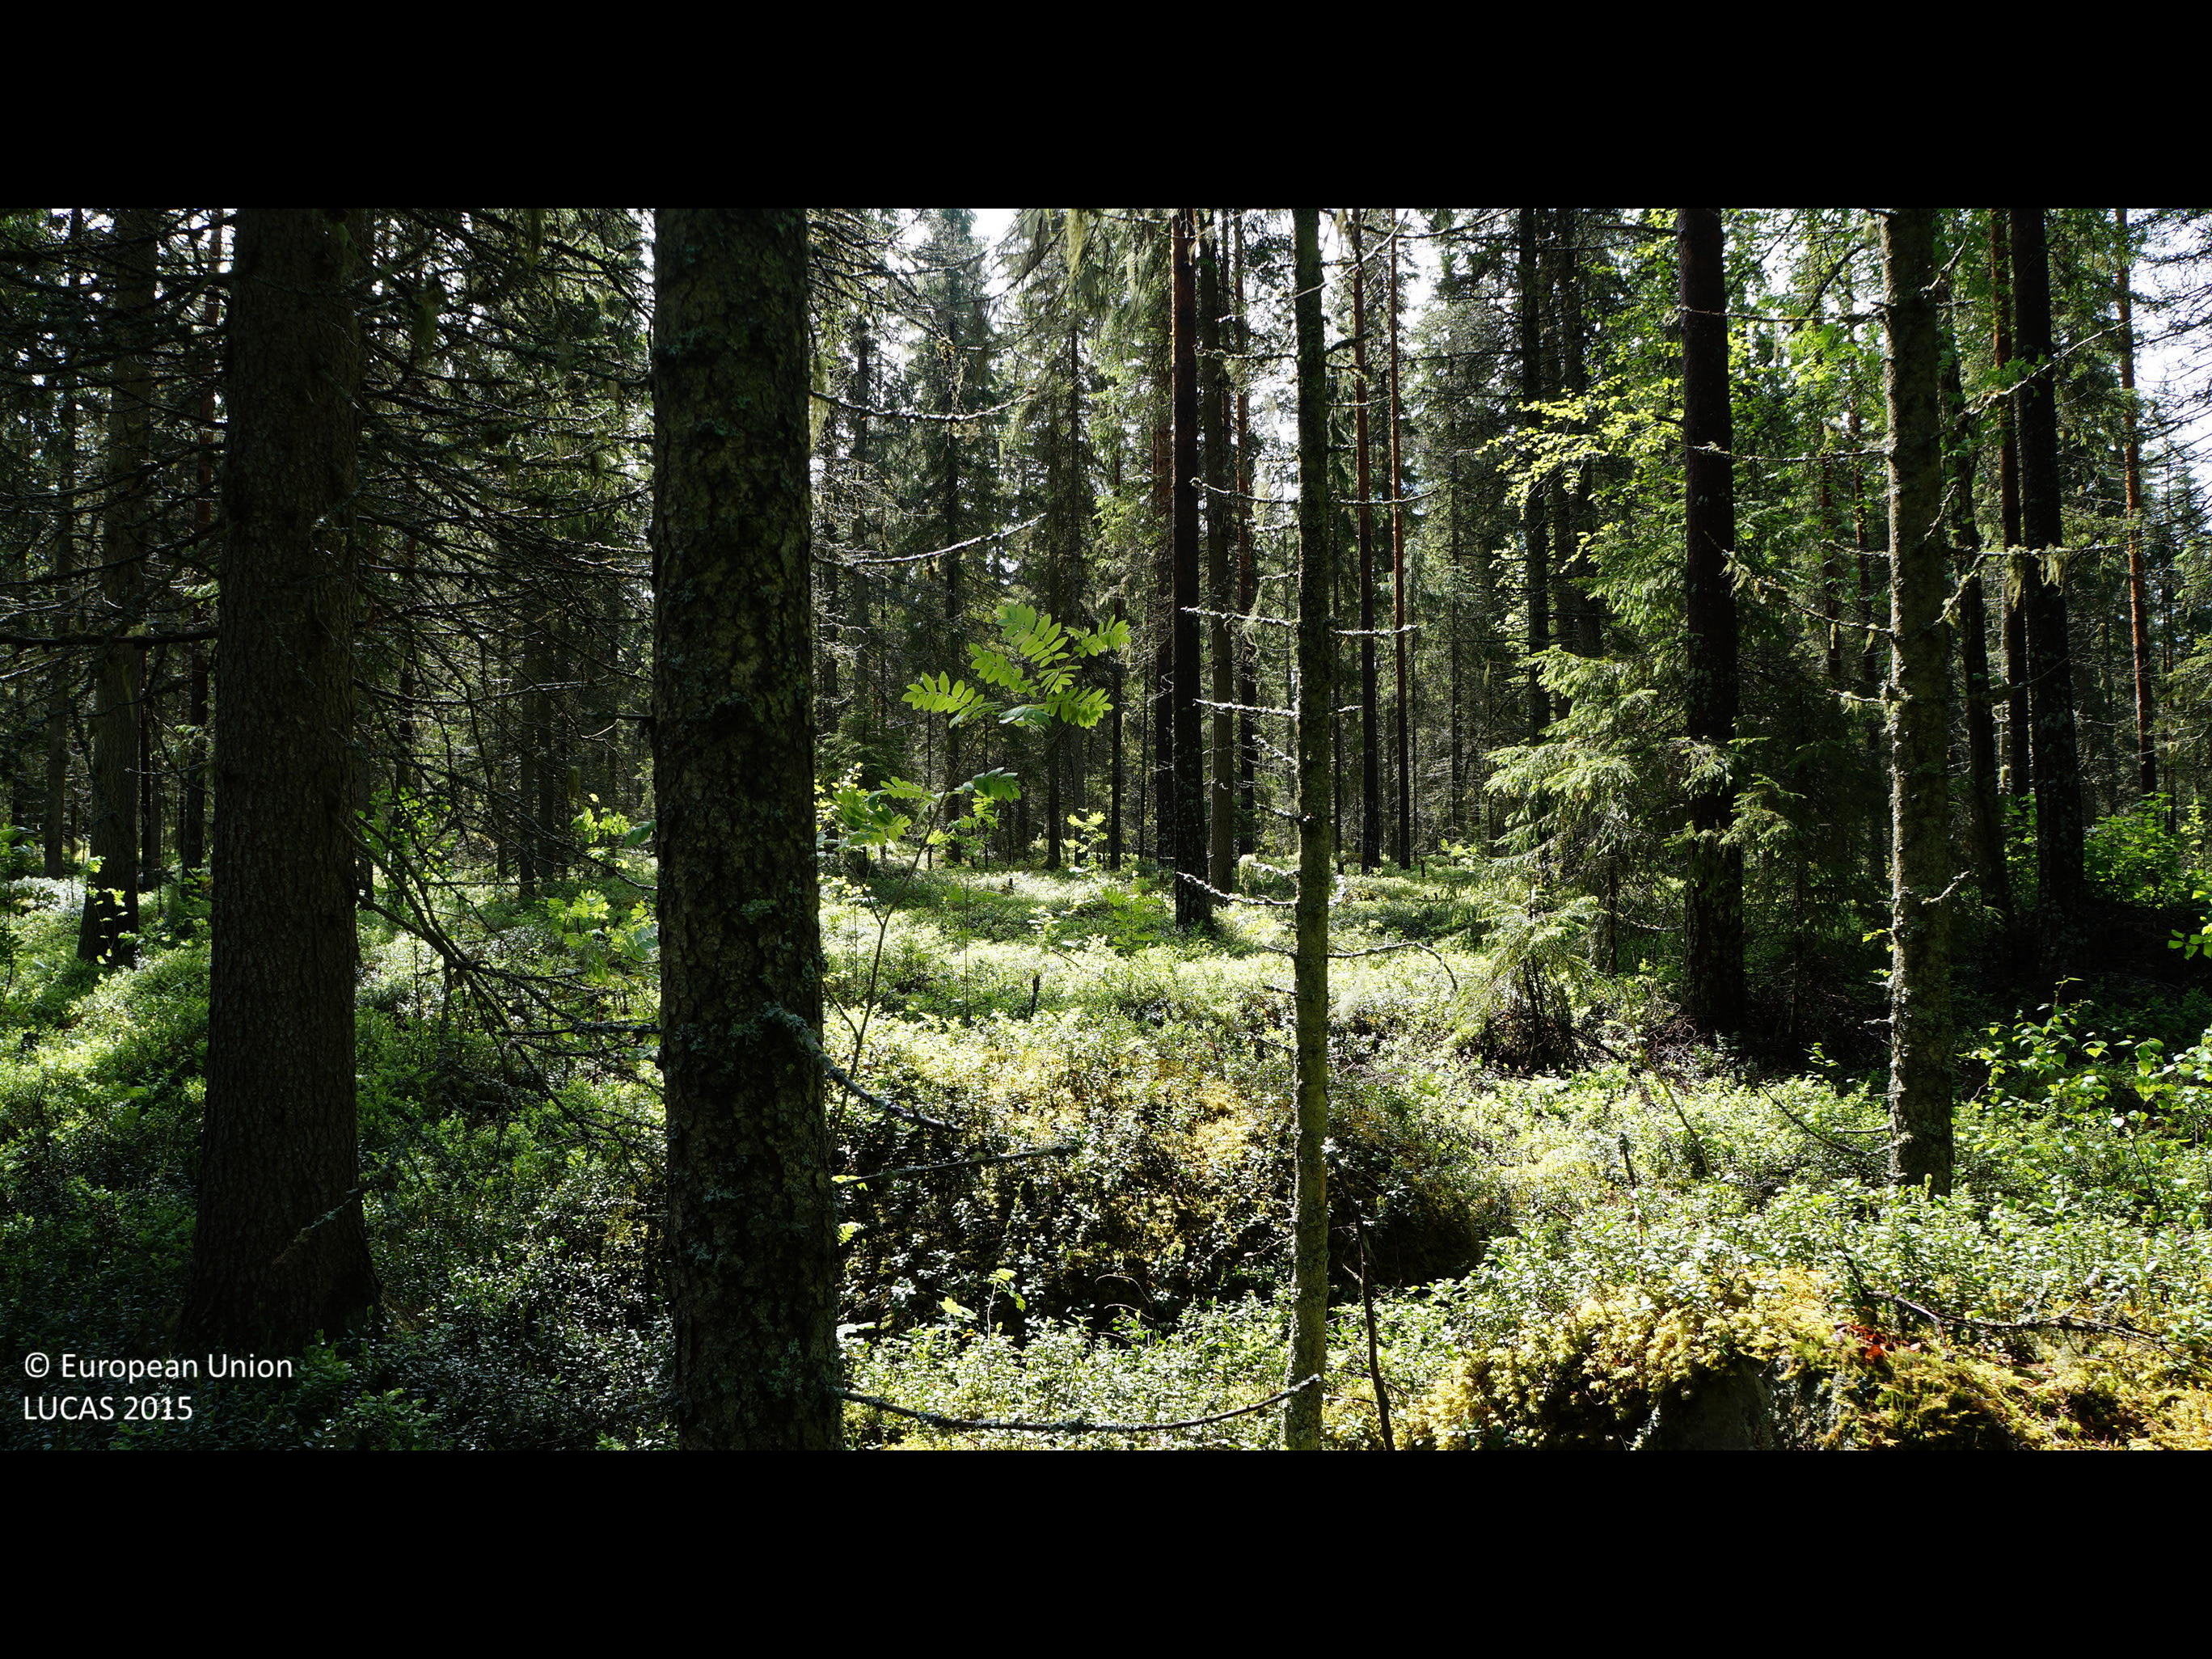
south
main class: Woodland
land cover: Spruce dominated coniferous woodland
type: boreal forest
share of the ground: > 75 %
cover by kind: coniferous forest trees 75 %, herbaceous plants 10 %, broadleaved forest trees 5 %, shrubs 5 %, lichens and mosses 5 %
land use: Forestry
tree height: > 5 m
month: June
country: FI
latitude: 64.0874
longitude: 23.7819
